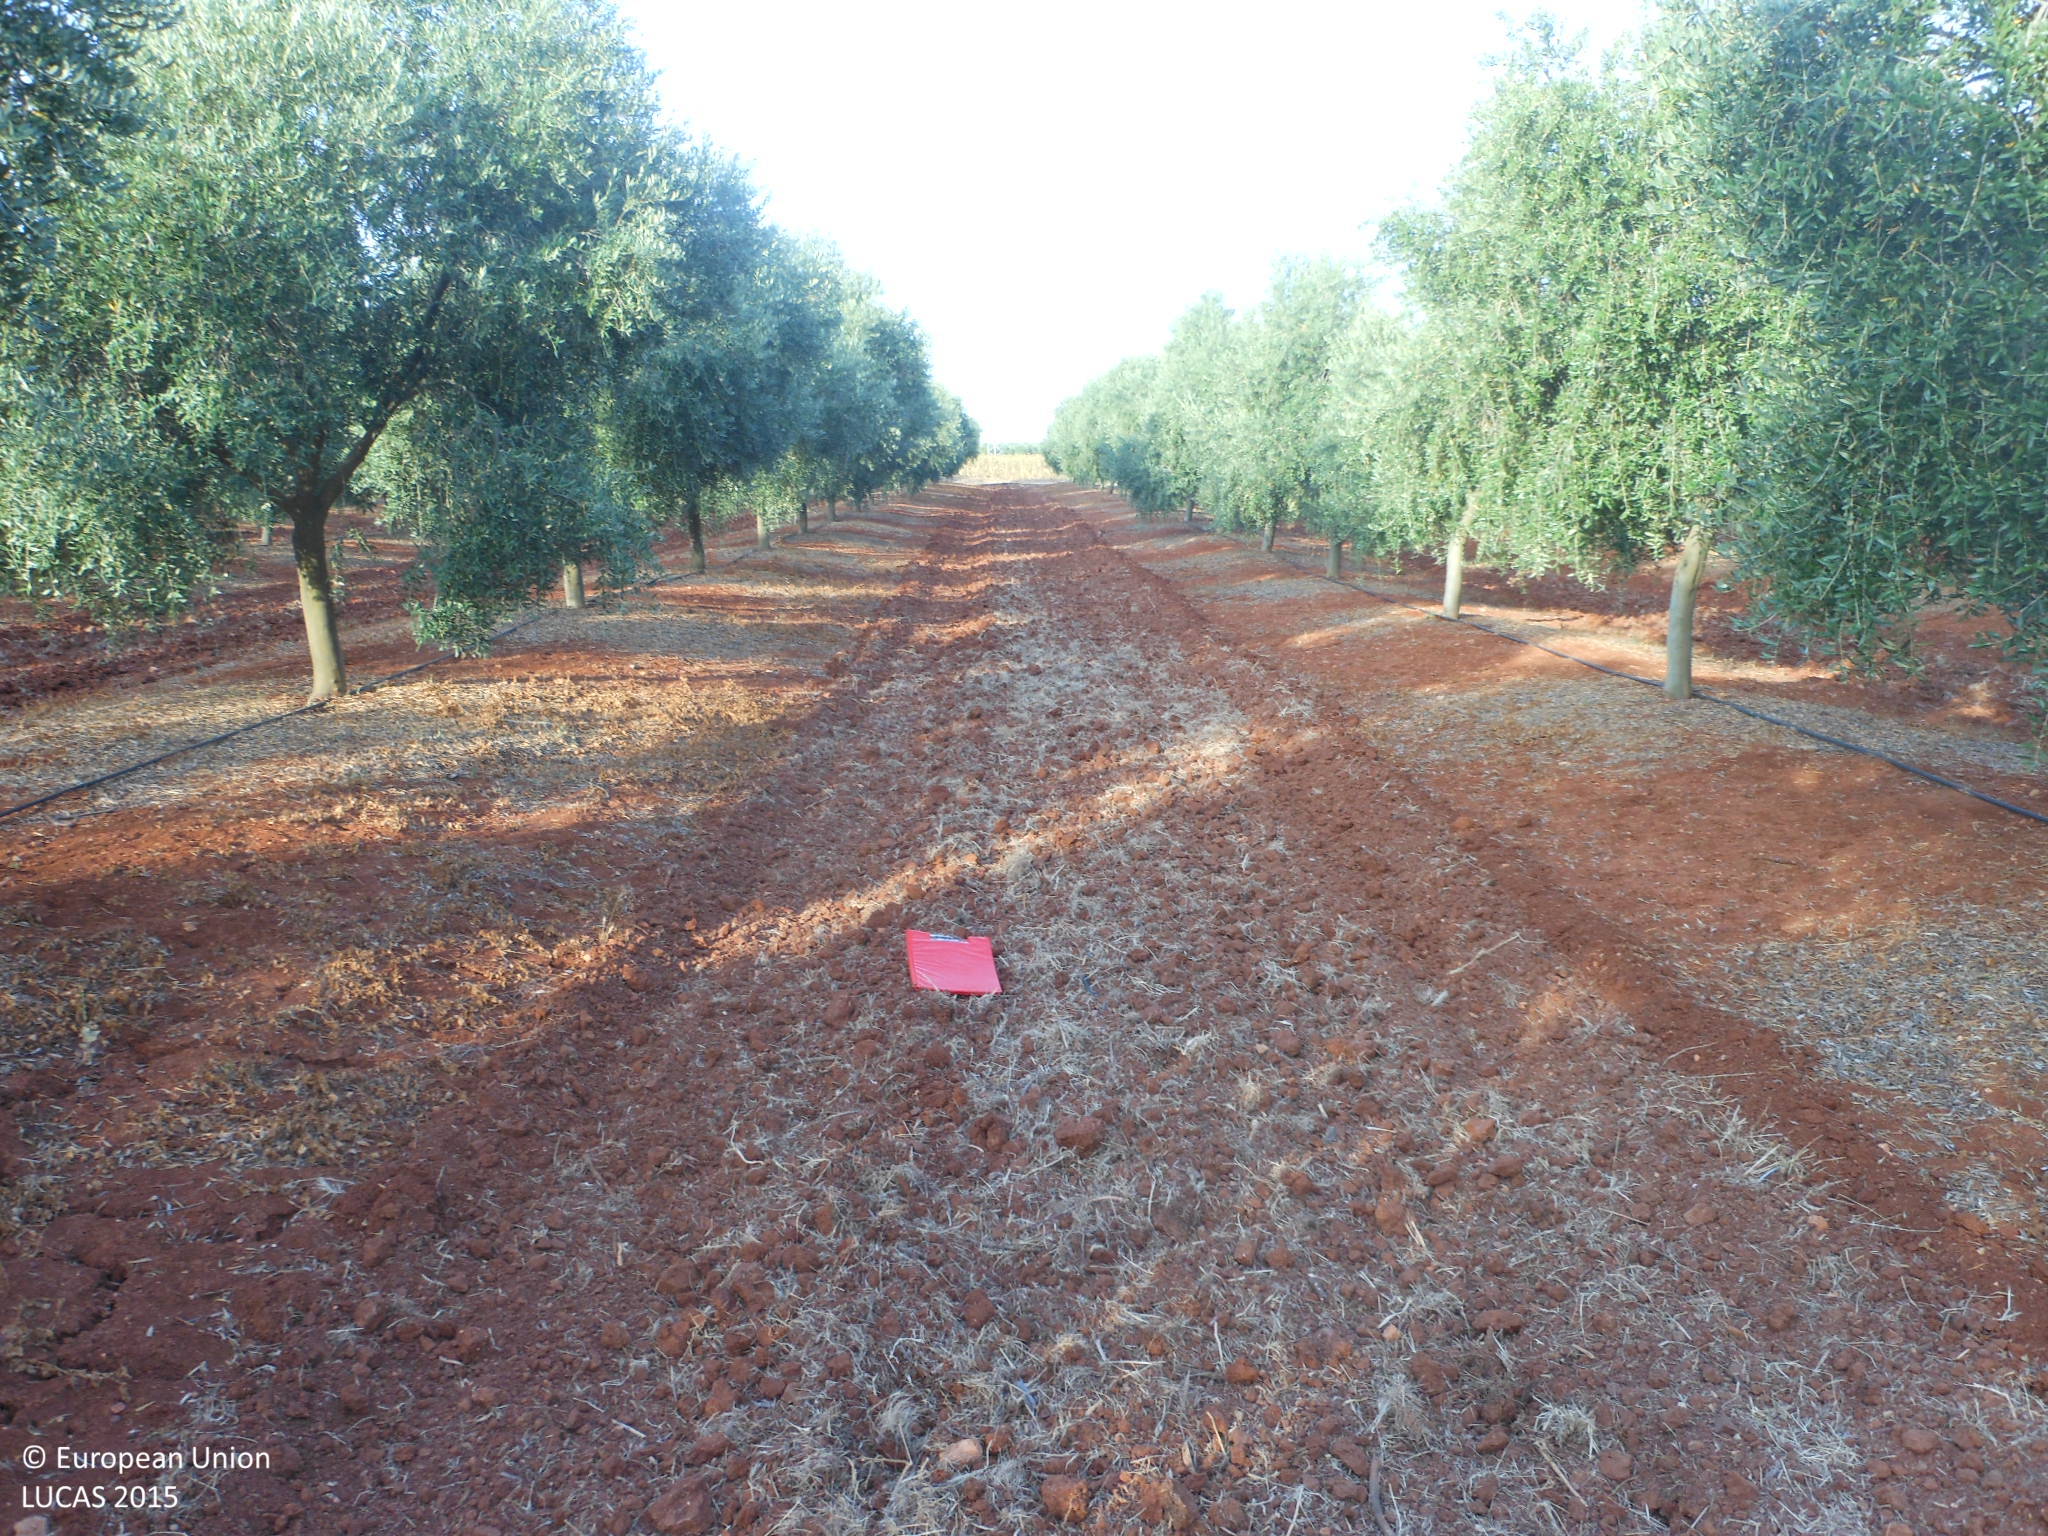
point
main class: Cropland
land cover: Olive groves
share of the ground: 25 - 50 %
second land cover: Other bare soil
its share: > 75 %
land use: Agriculture (excluding fallow land and kitchen gardens)
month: July
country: ES
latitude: 37.4825
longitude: -5.1552
